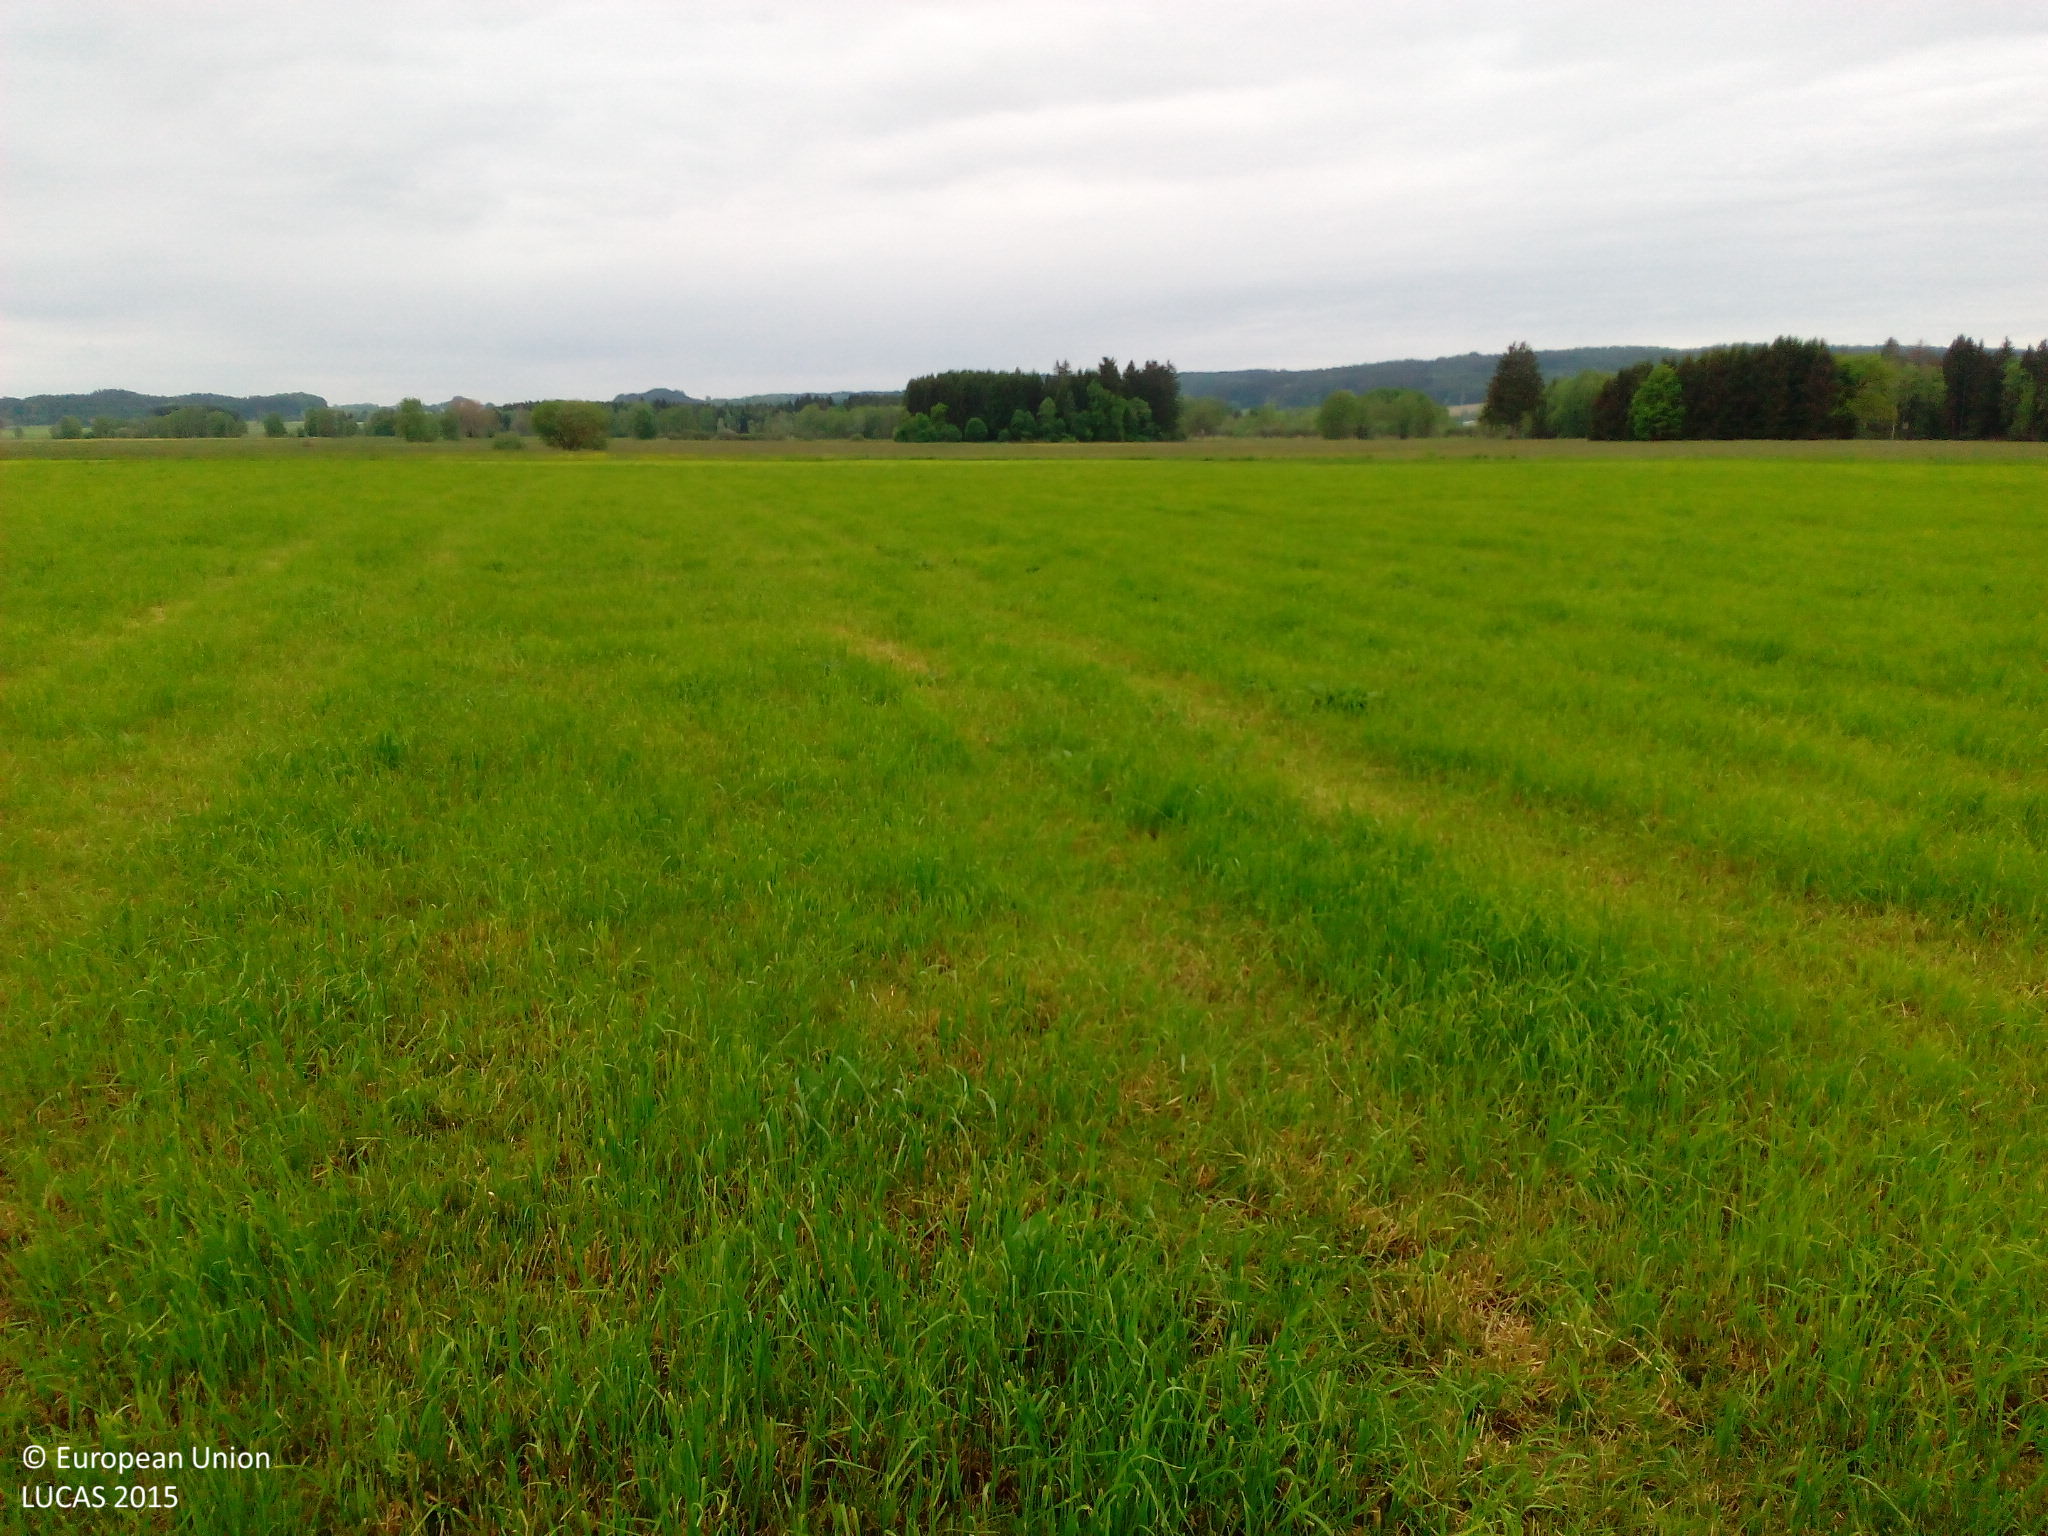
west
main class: Grassland
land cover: Grassland without tree/shrub cover
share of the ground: > 75 %
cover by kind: herbaceous plants 100 %
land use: Agriculture (excluding fallow land and kitchen gardens)
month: May
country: DE
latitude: 47.8816
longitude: 9.9332
